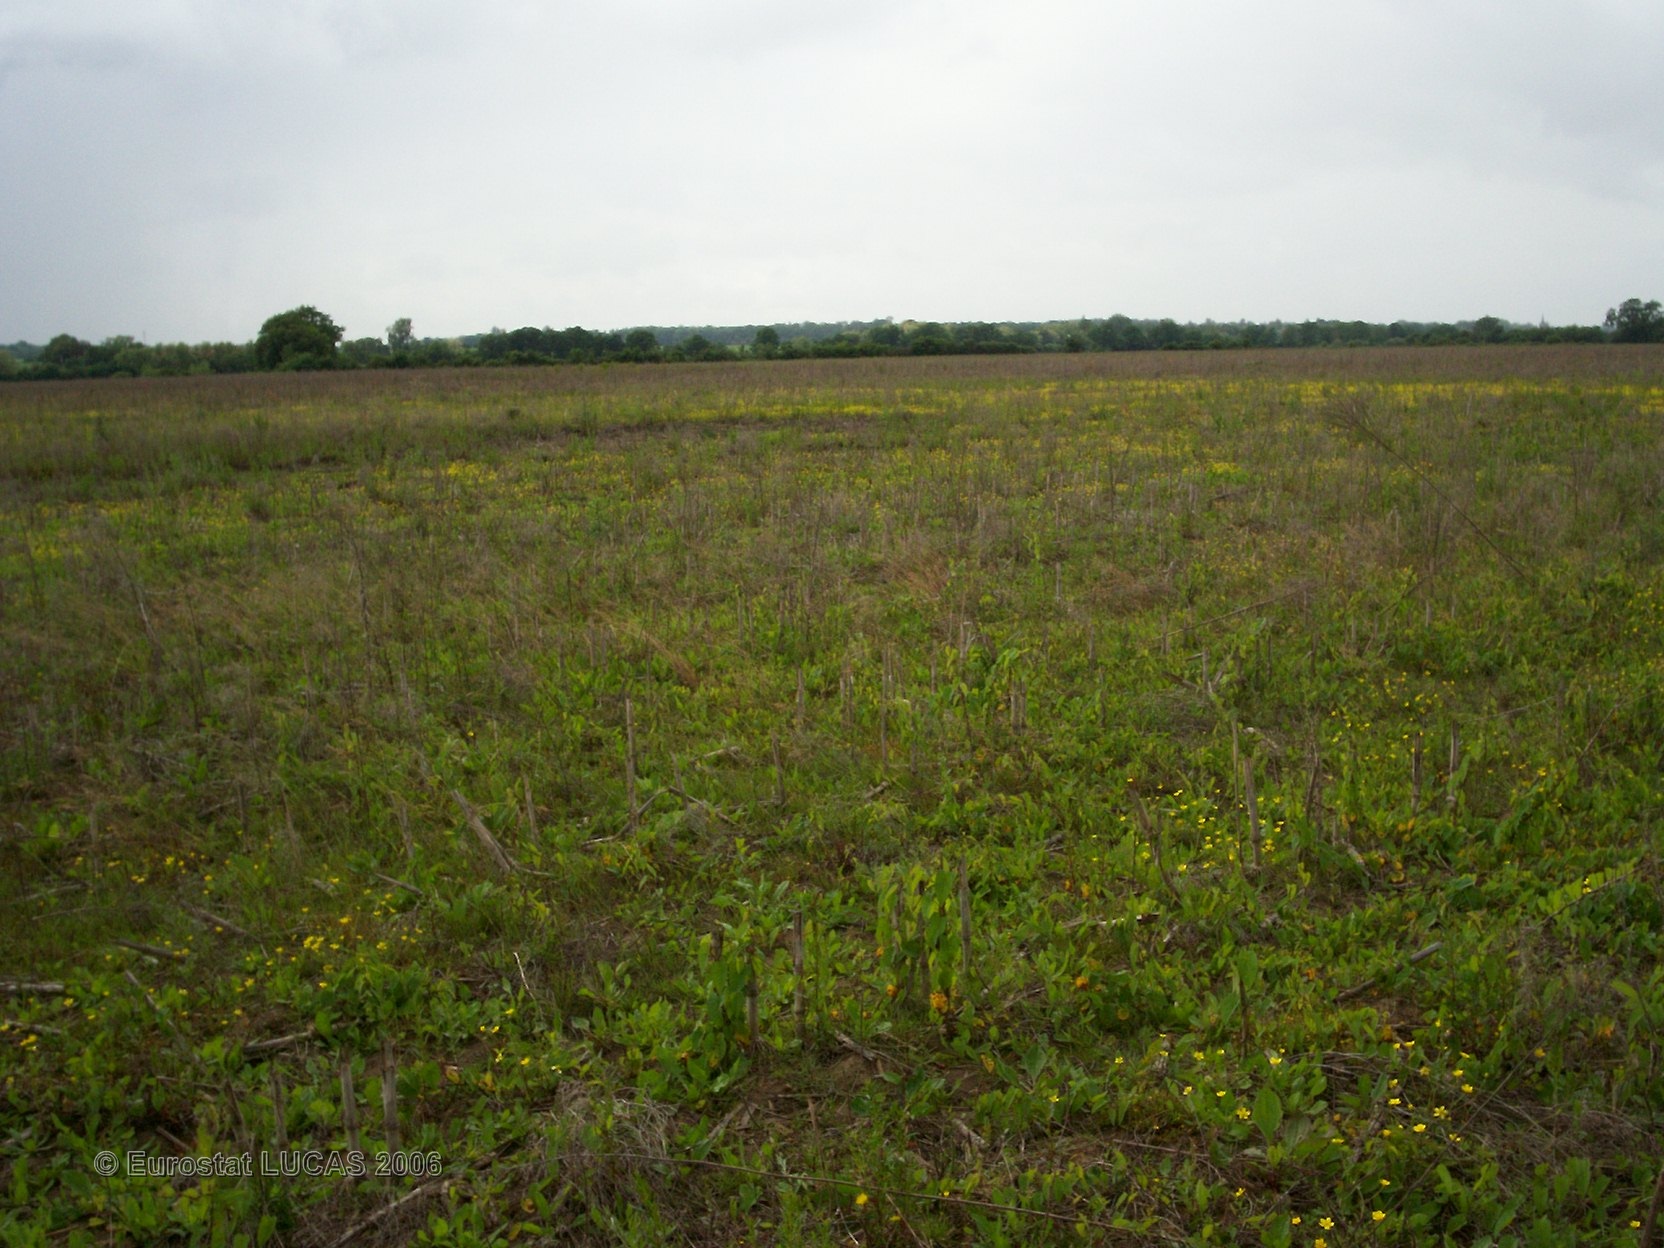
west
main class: Grassland
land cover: Grassland without tree/shrub cover
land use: Fallow land
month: May
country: FR
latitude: 47.2051
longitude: 2.9849
